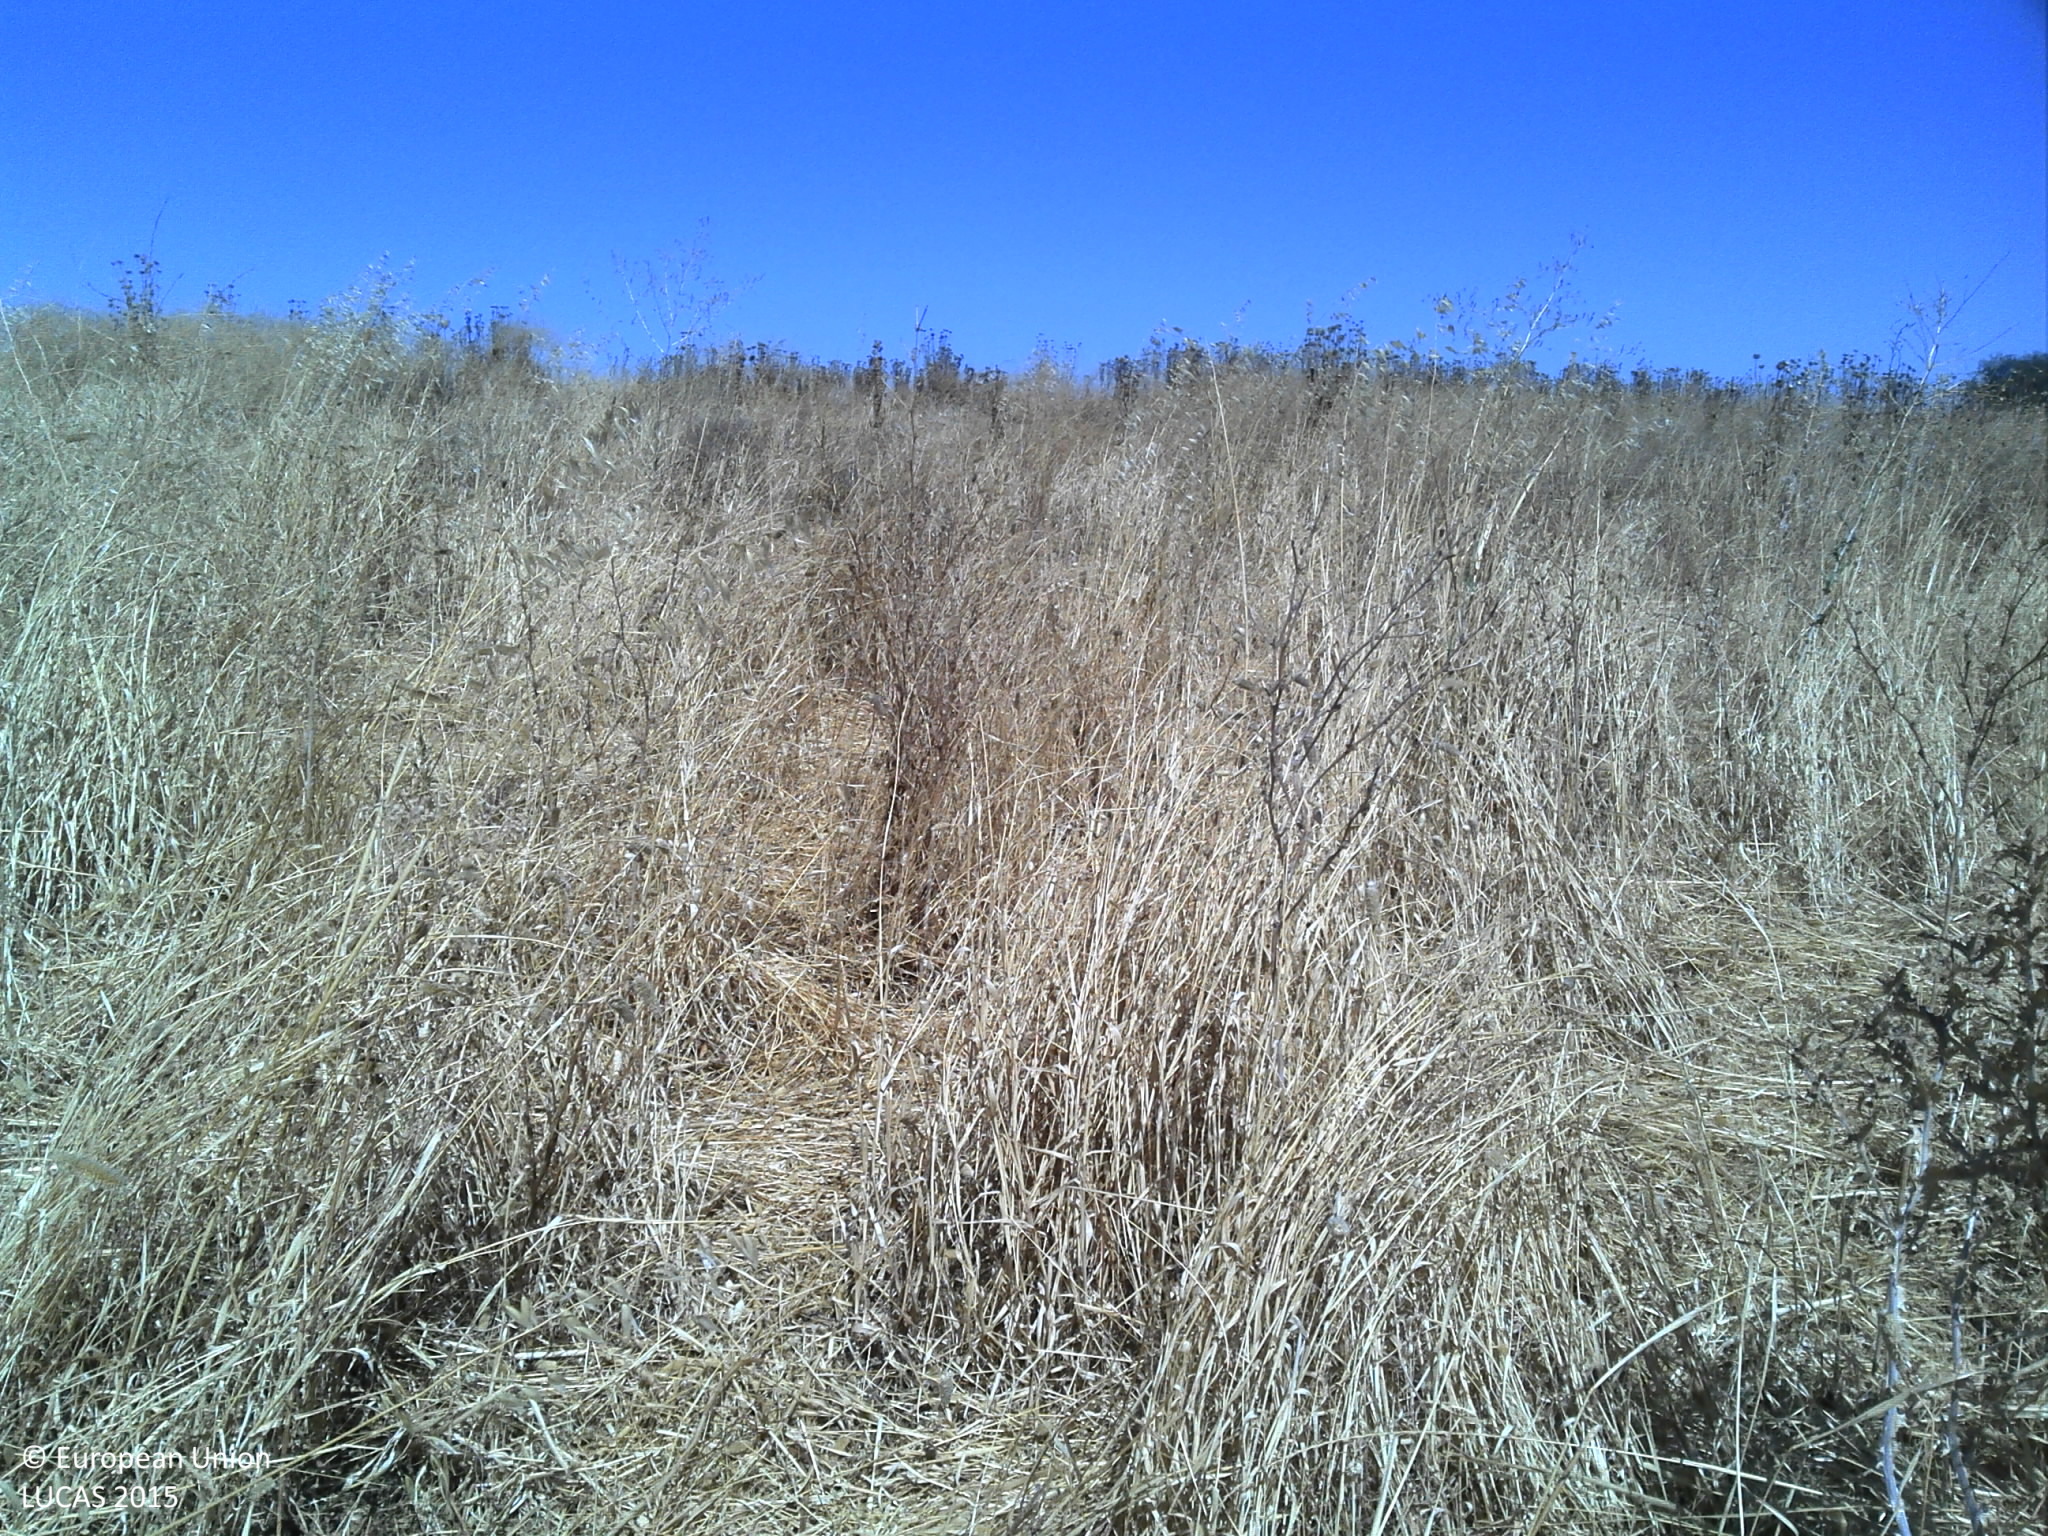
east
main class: Grassland
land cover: Grassland without tree/shrub cover
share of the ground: > 75 %
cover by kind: herbaceous plants 85 %, unconsolidated bare surface 15 %
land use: Agriculture (excluding fallow land and kitchen gardens)
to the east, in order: Grassland without tree/shrub cover
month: July
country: PT
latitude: 38.1577
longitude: -7.7281
